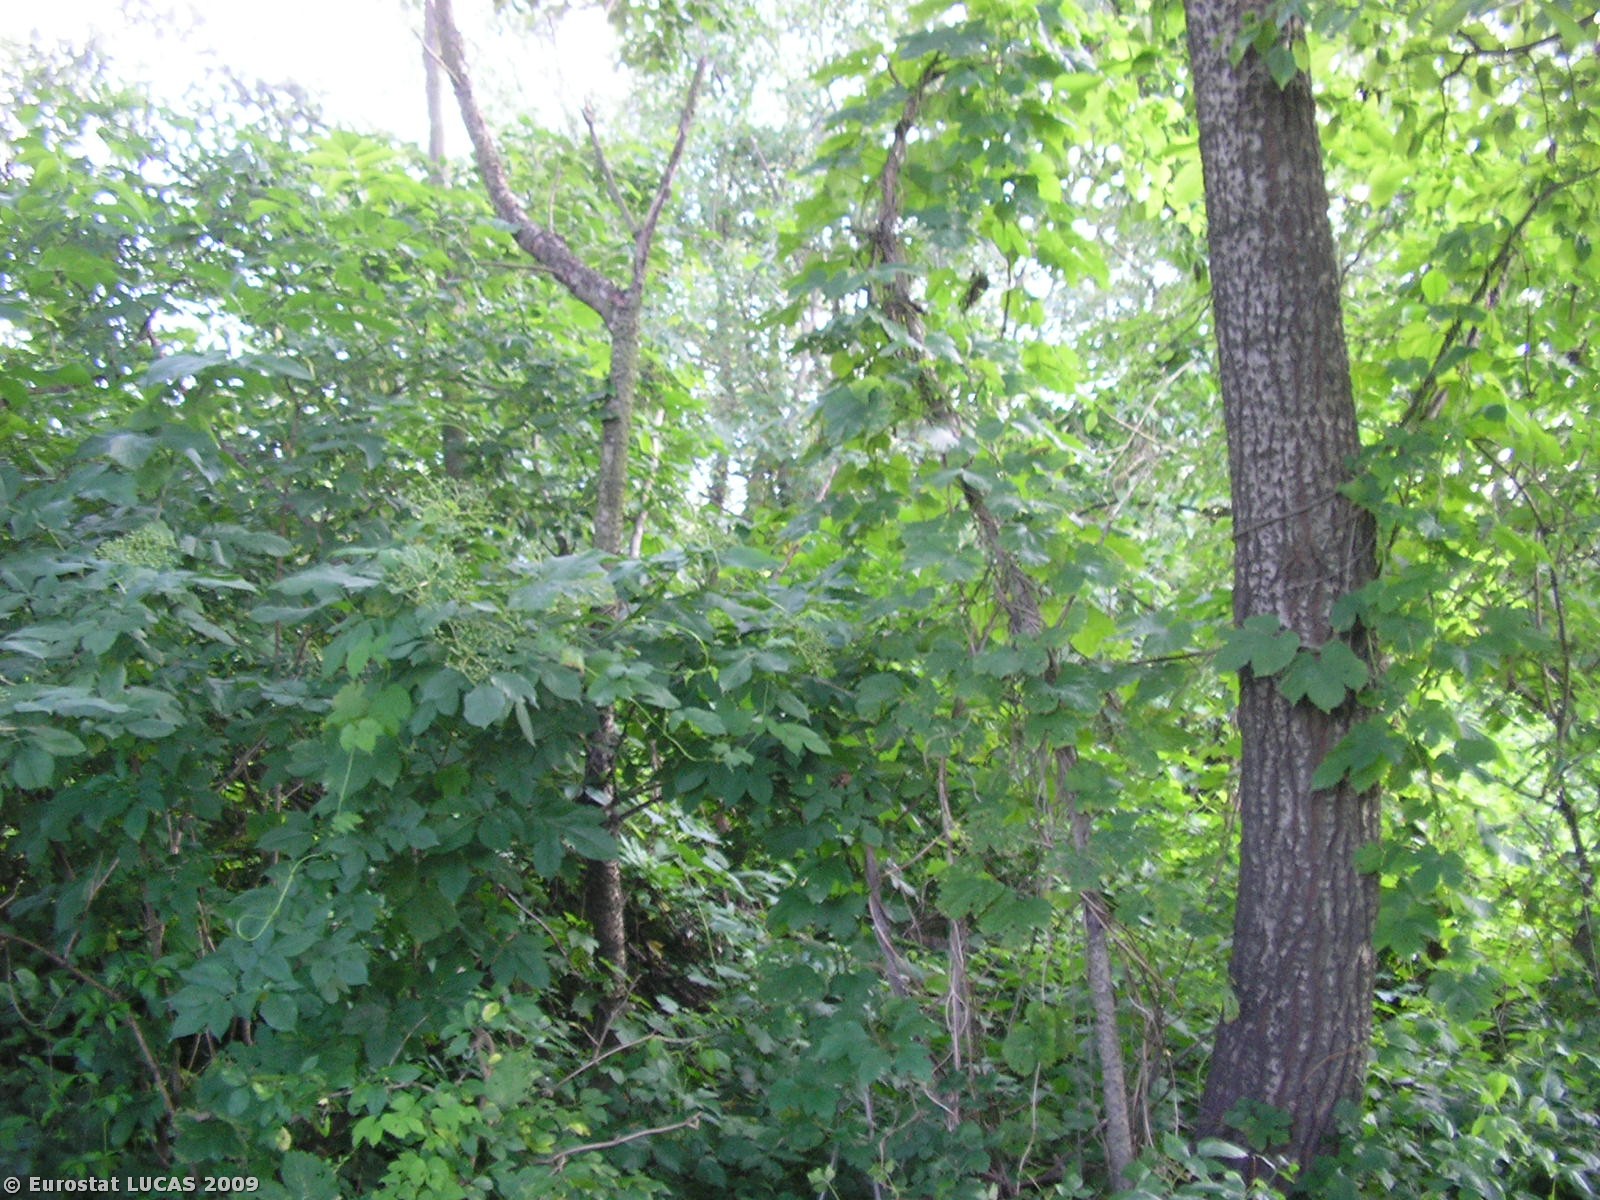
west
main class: Woodland
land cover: Broadleaved woodland
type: mesophytic deciduous forest
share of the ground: > 75 %
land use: Unused
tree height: > 5 m
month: July
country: PL
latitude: 50.2379
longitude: 20.7384
